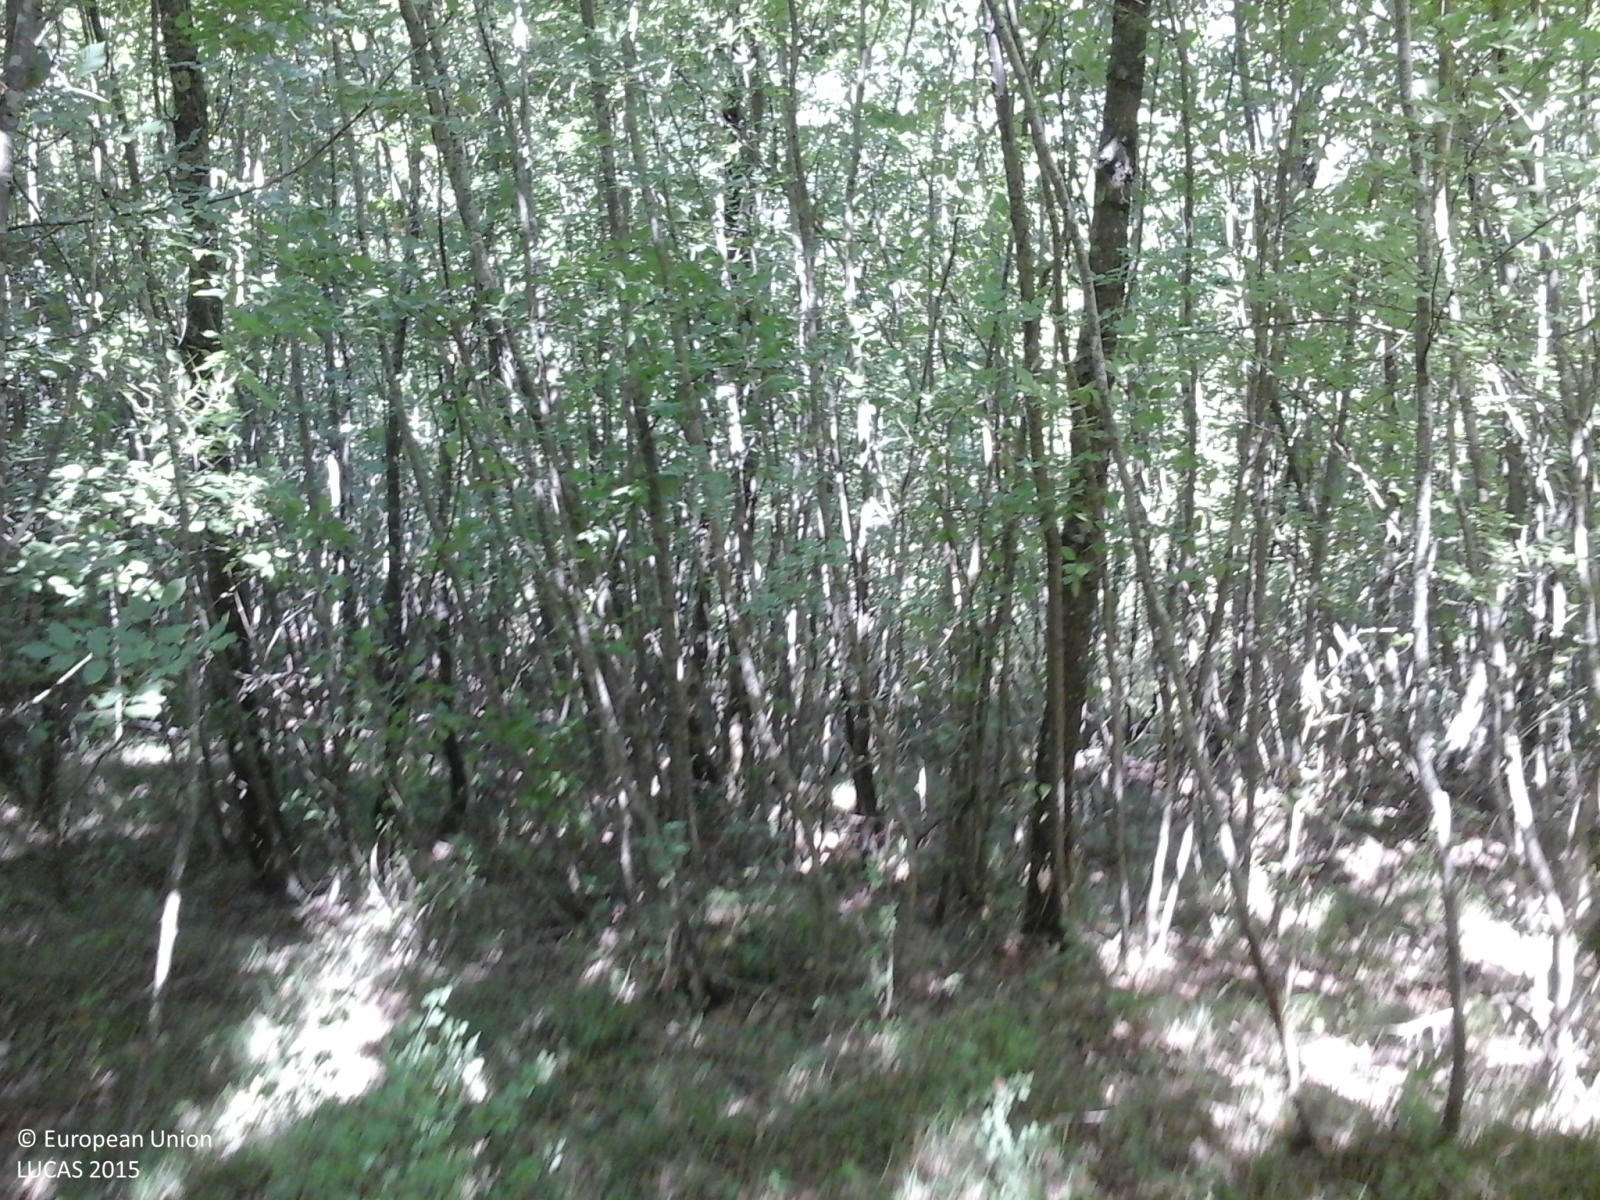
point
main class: Woodland
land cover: Broadleaved woodland
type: thermophilous deciduous forest
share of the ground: > 75 %
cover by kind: broadleaved forest trees 100 %
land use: Forestry
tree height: > 5 m
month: August
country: IT
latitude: 43.4581
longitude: 12.3296
